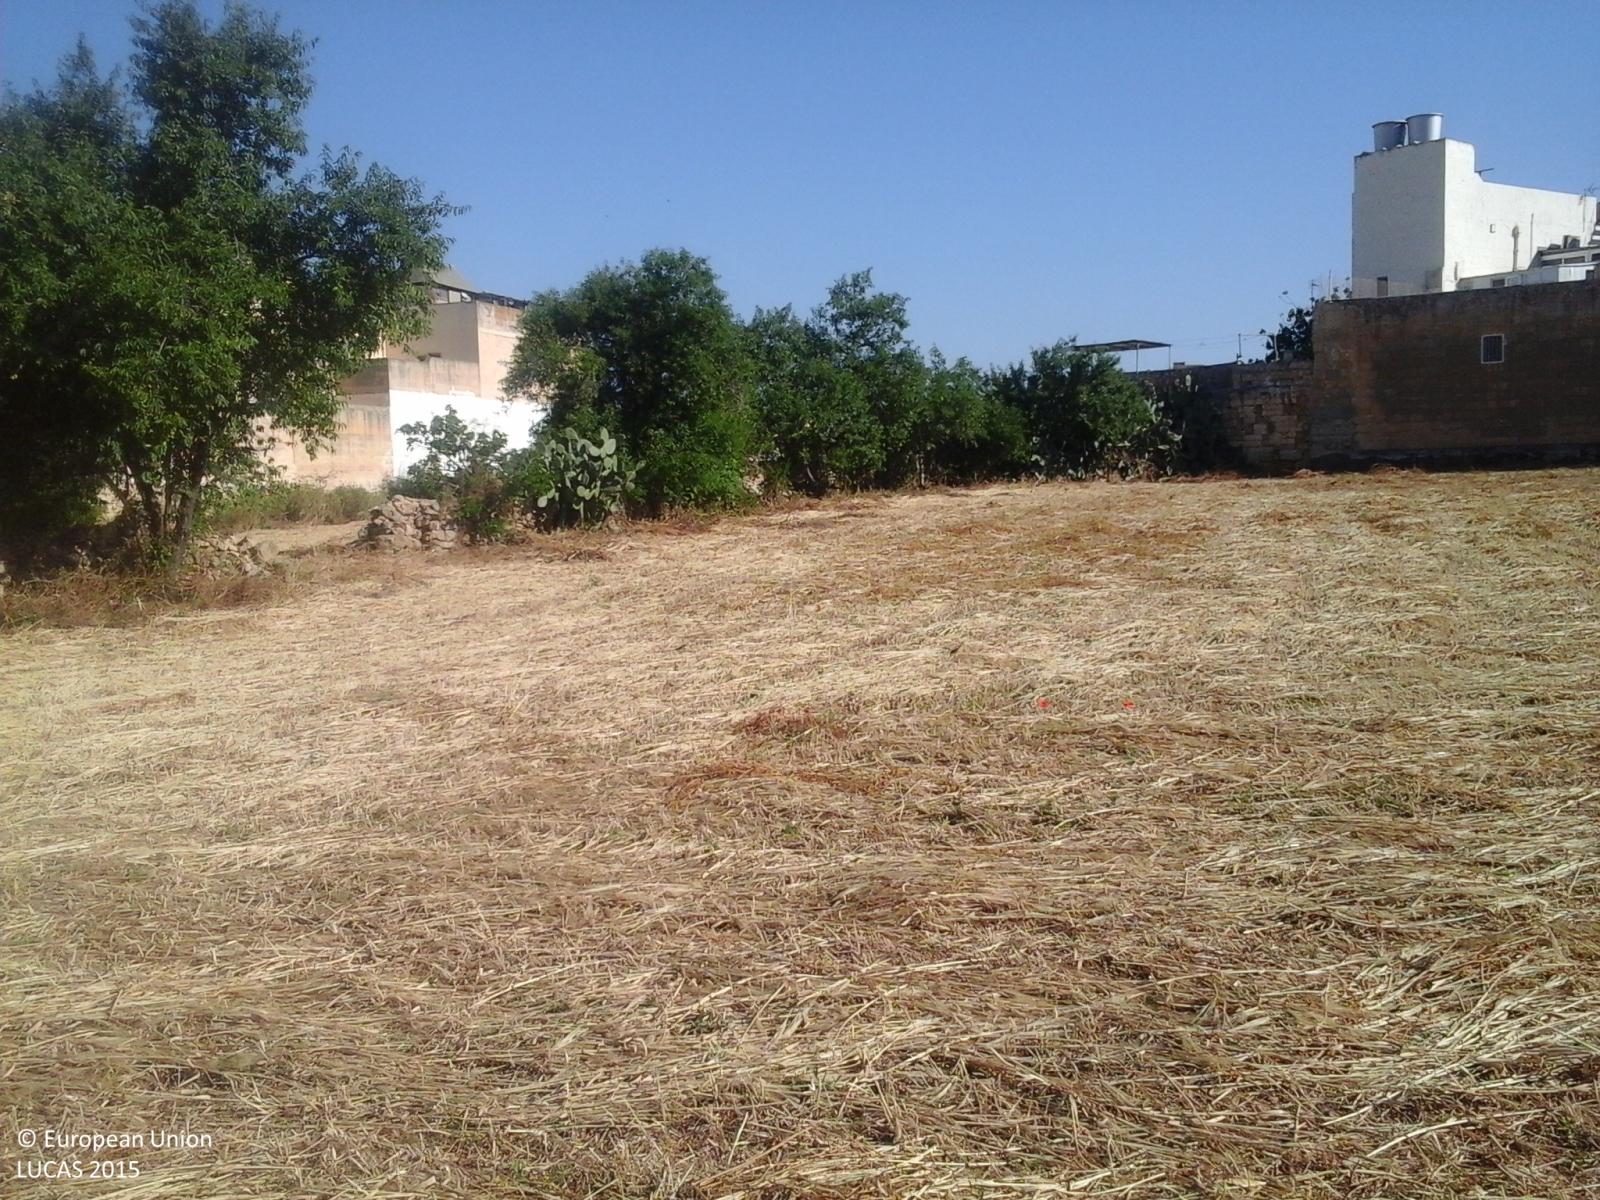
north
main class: Cropland
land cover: Mixed cereals for fodder
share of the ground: > 75 %
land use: Agriculture (excluding fallow land and kitchen gardens)
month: May
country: MT
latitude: 35.8582
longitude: 14.4875
